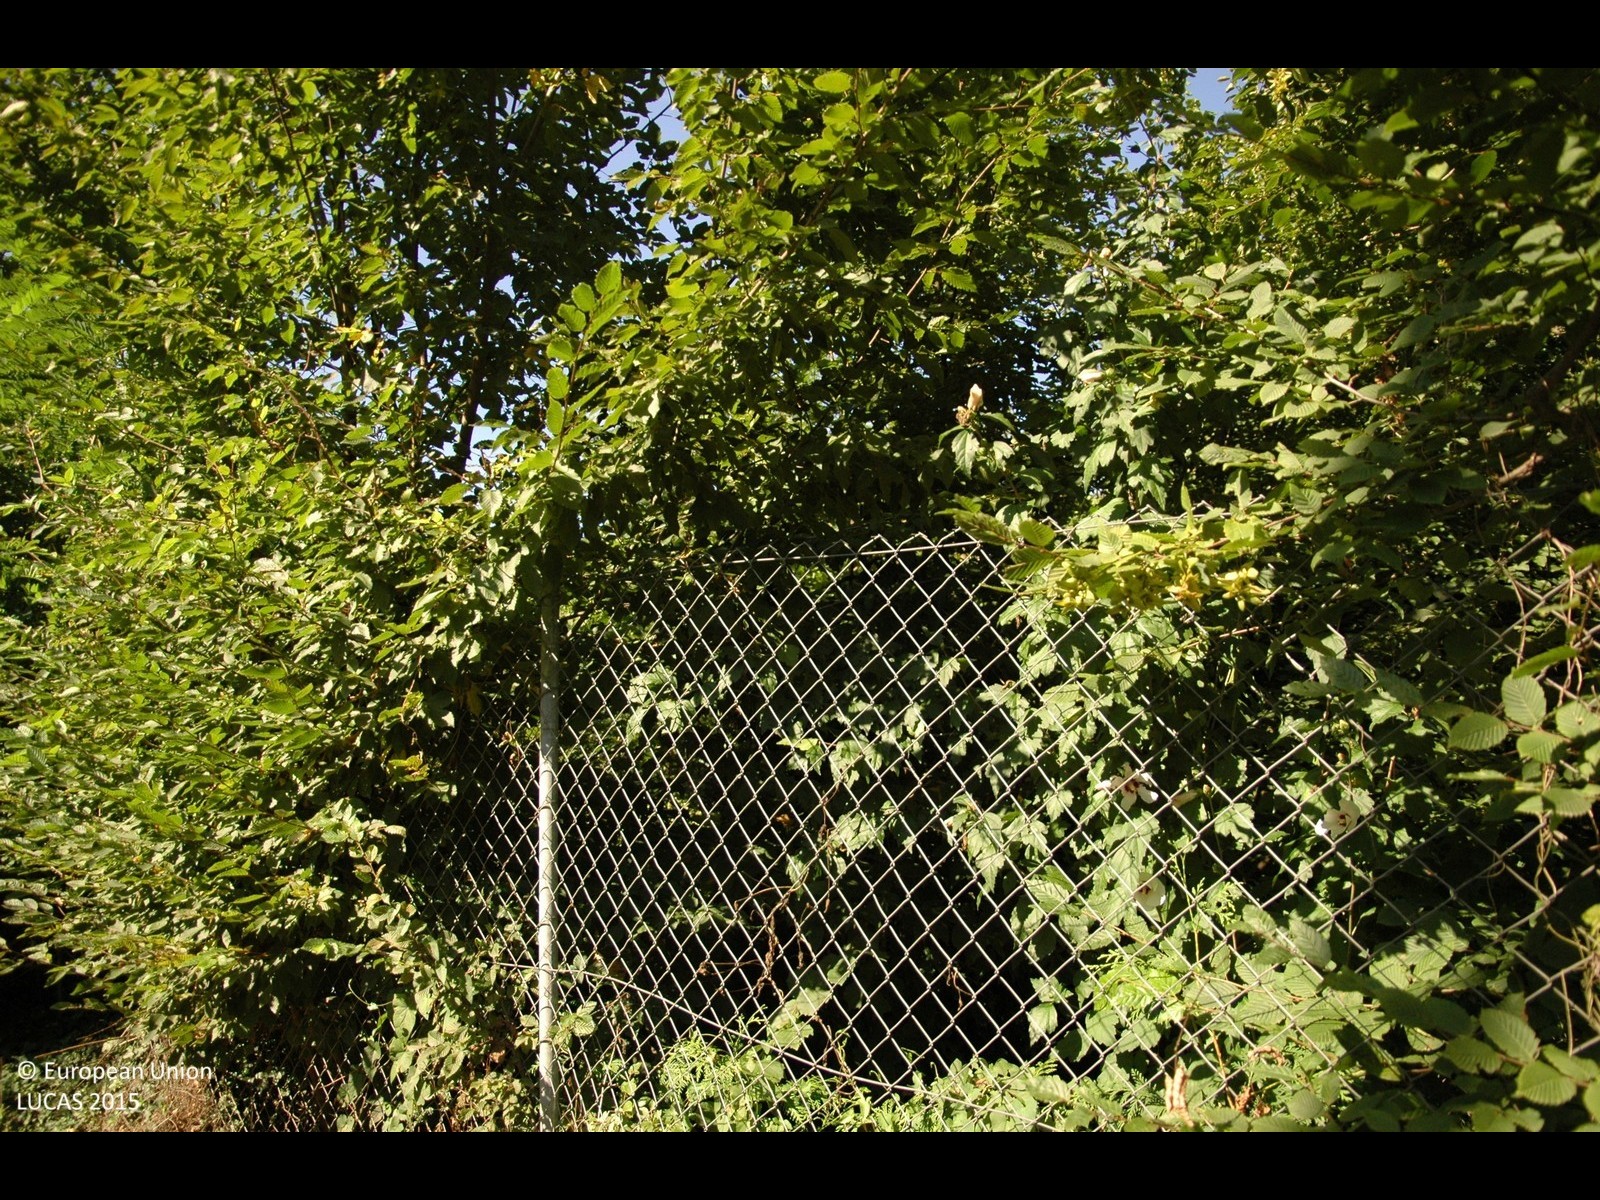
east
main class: Woodland
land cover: Broadleaved woodland
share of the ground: > 75 %
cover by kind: broadleaved forest trees 100 %
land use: Semi-natural and natural areas not in use
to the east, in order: Broadleaved woodland; Fences; Vineyards; Artificial constructions in urban areas; Vineyards
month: August
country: HR
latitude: 46.1724
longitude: 16.7753
